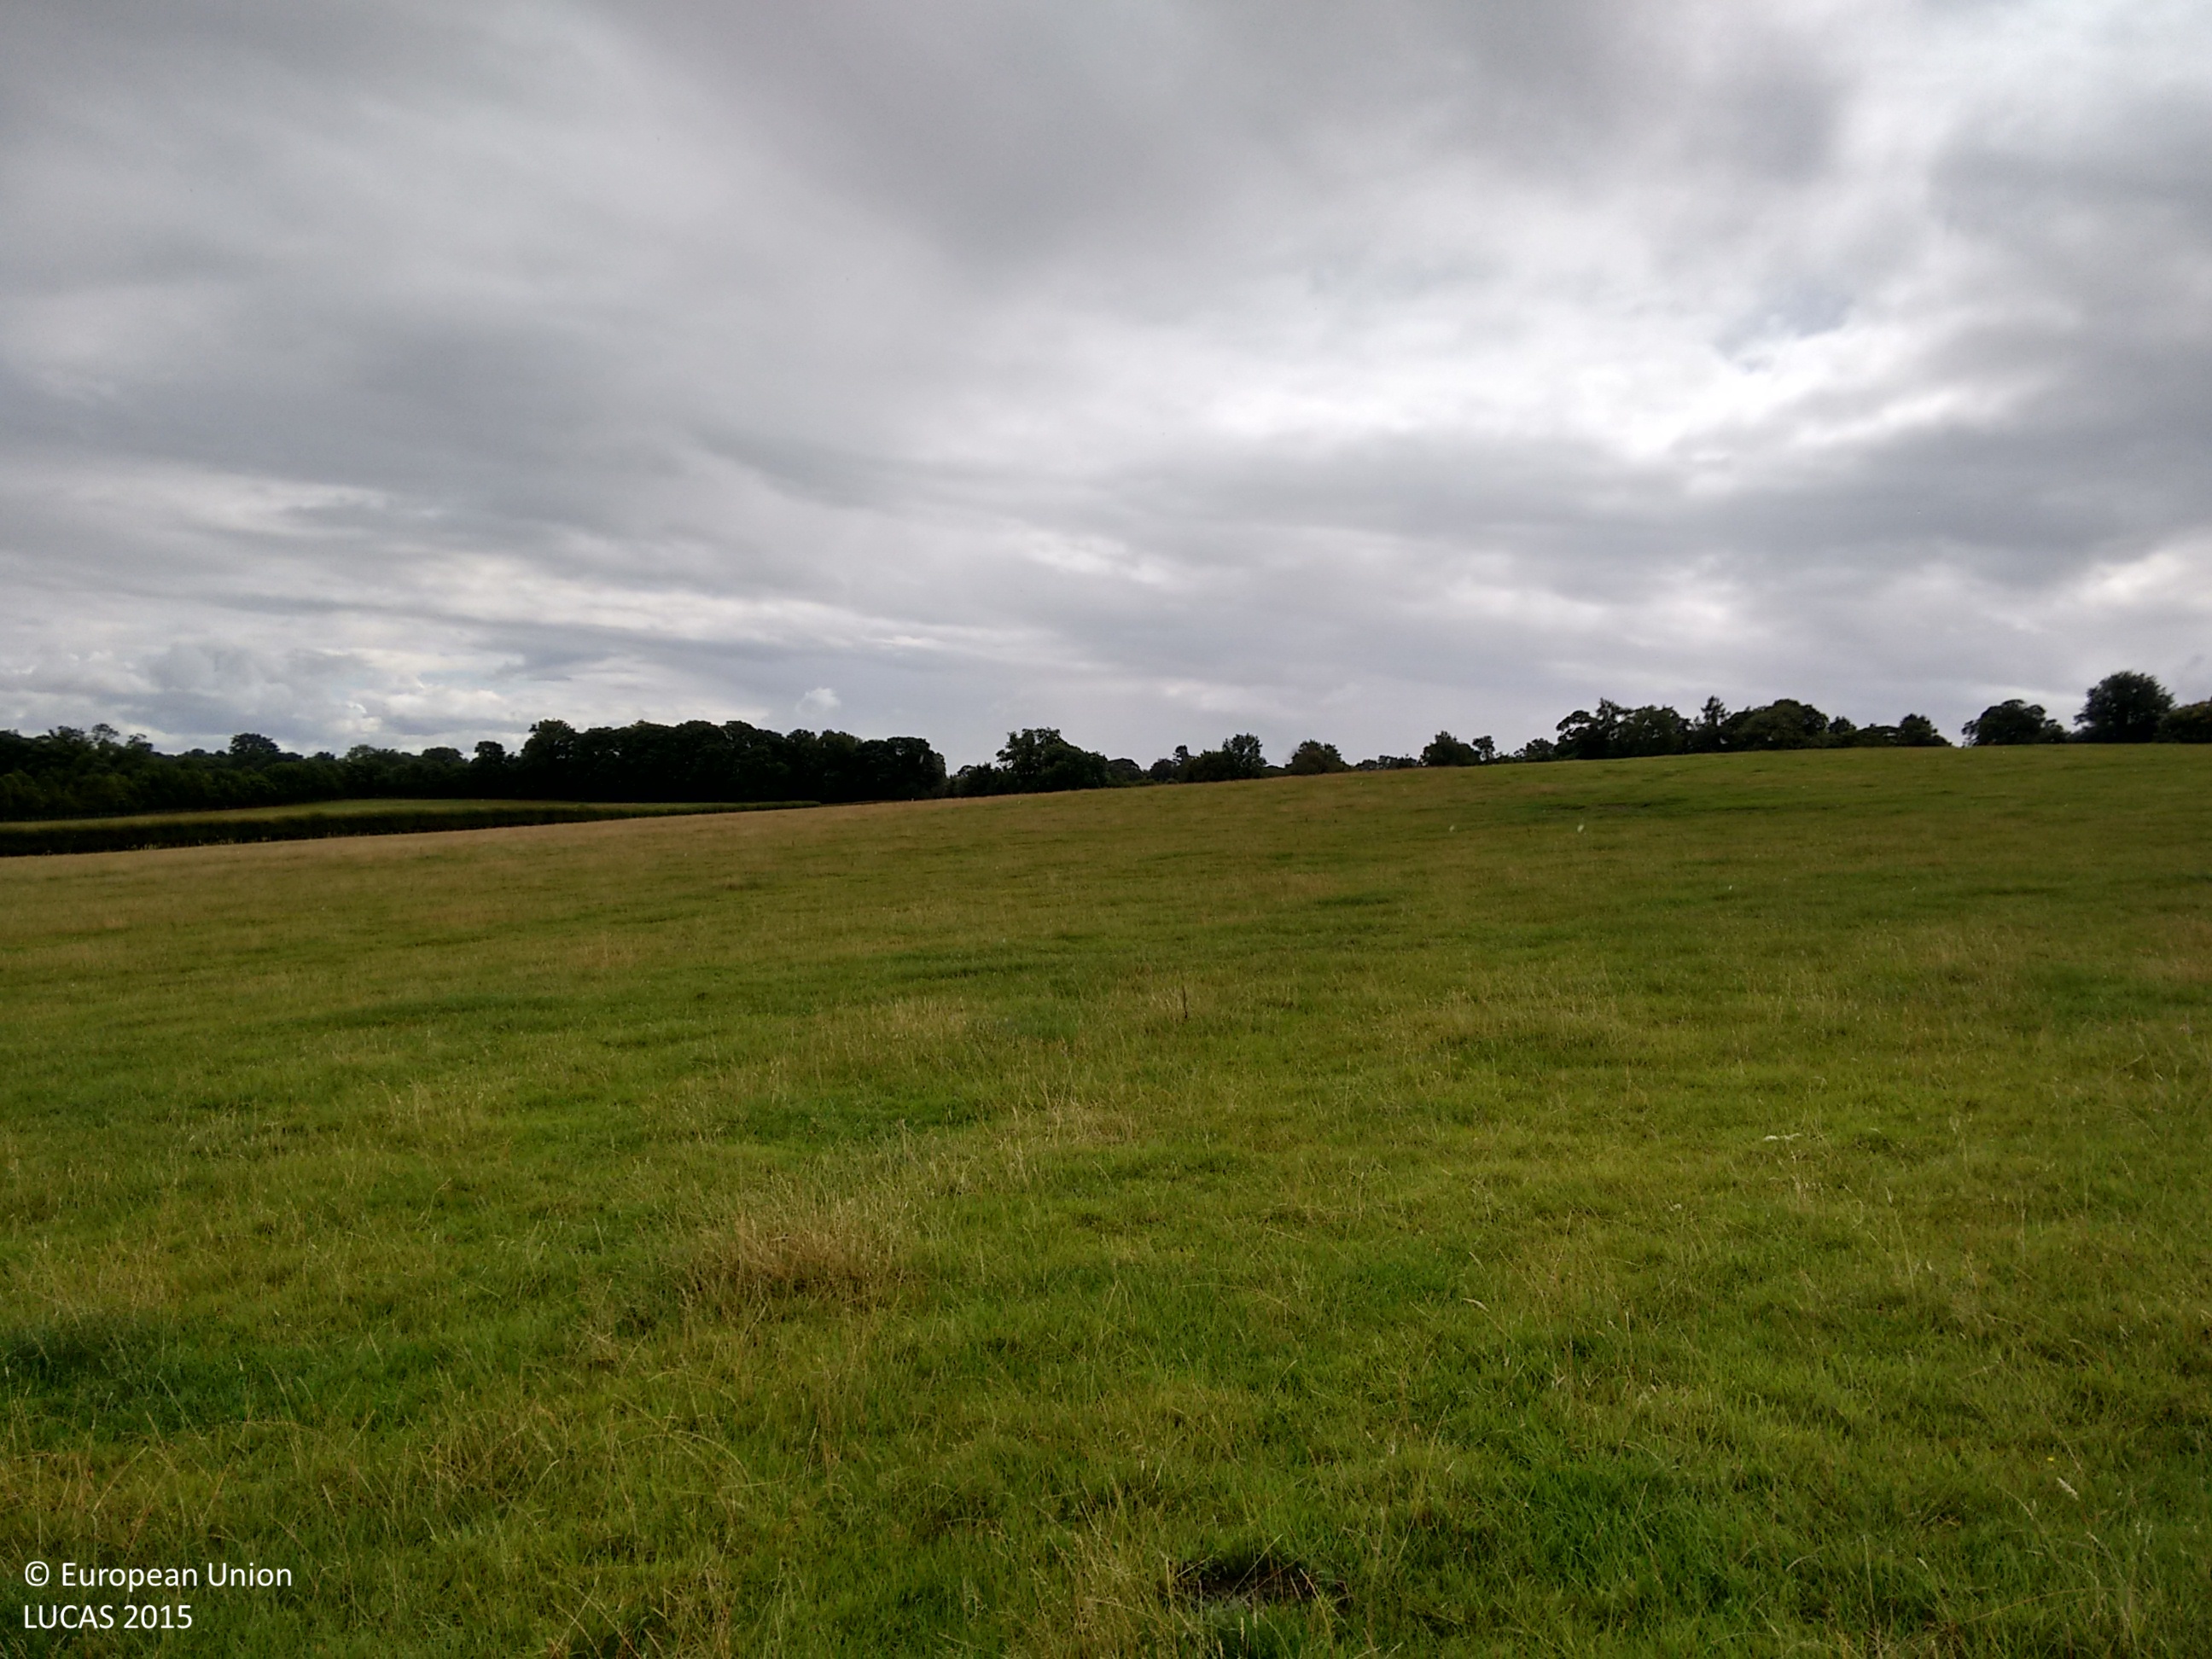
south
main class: Grassland
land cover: Grassland without tree/shrub cover
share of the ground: > 75 %
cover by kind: herbaceous plants 100 %
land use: Agriculture (excluding fallow land and kitchen gardens)
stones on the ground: < 10 %
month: September
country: GB
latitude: 53.0396
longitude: -3.0358
